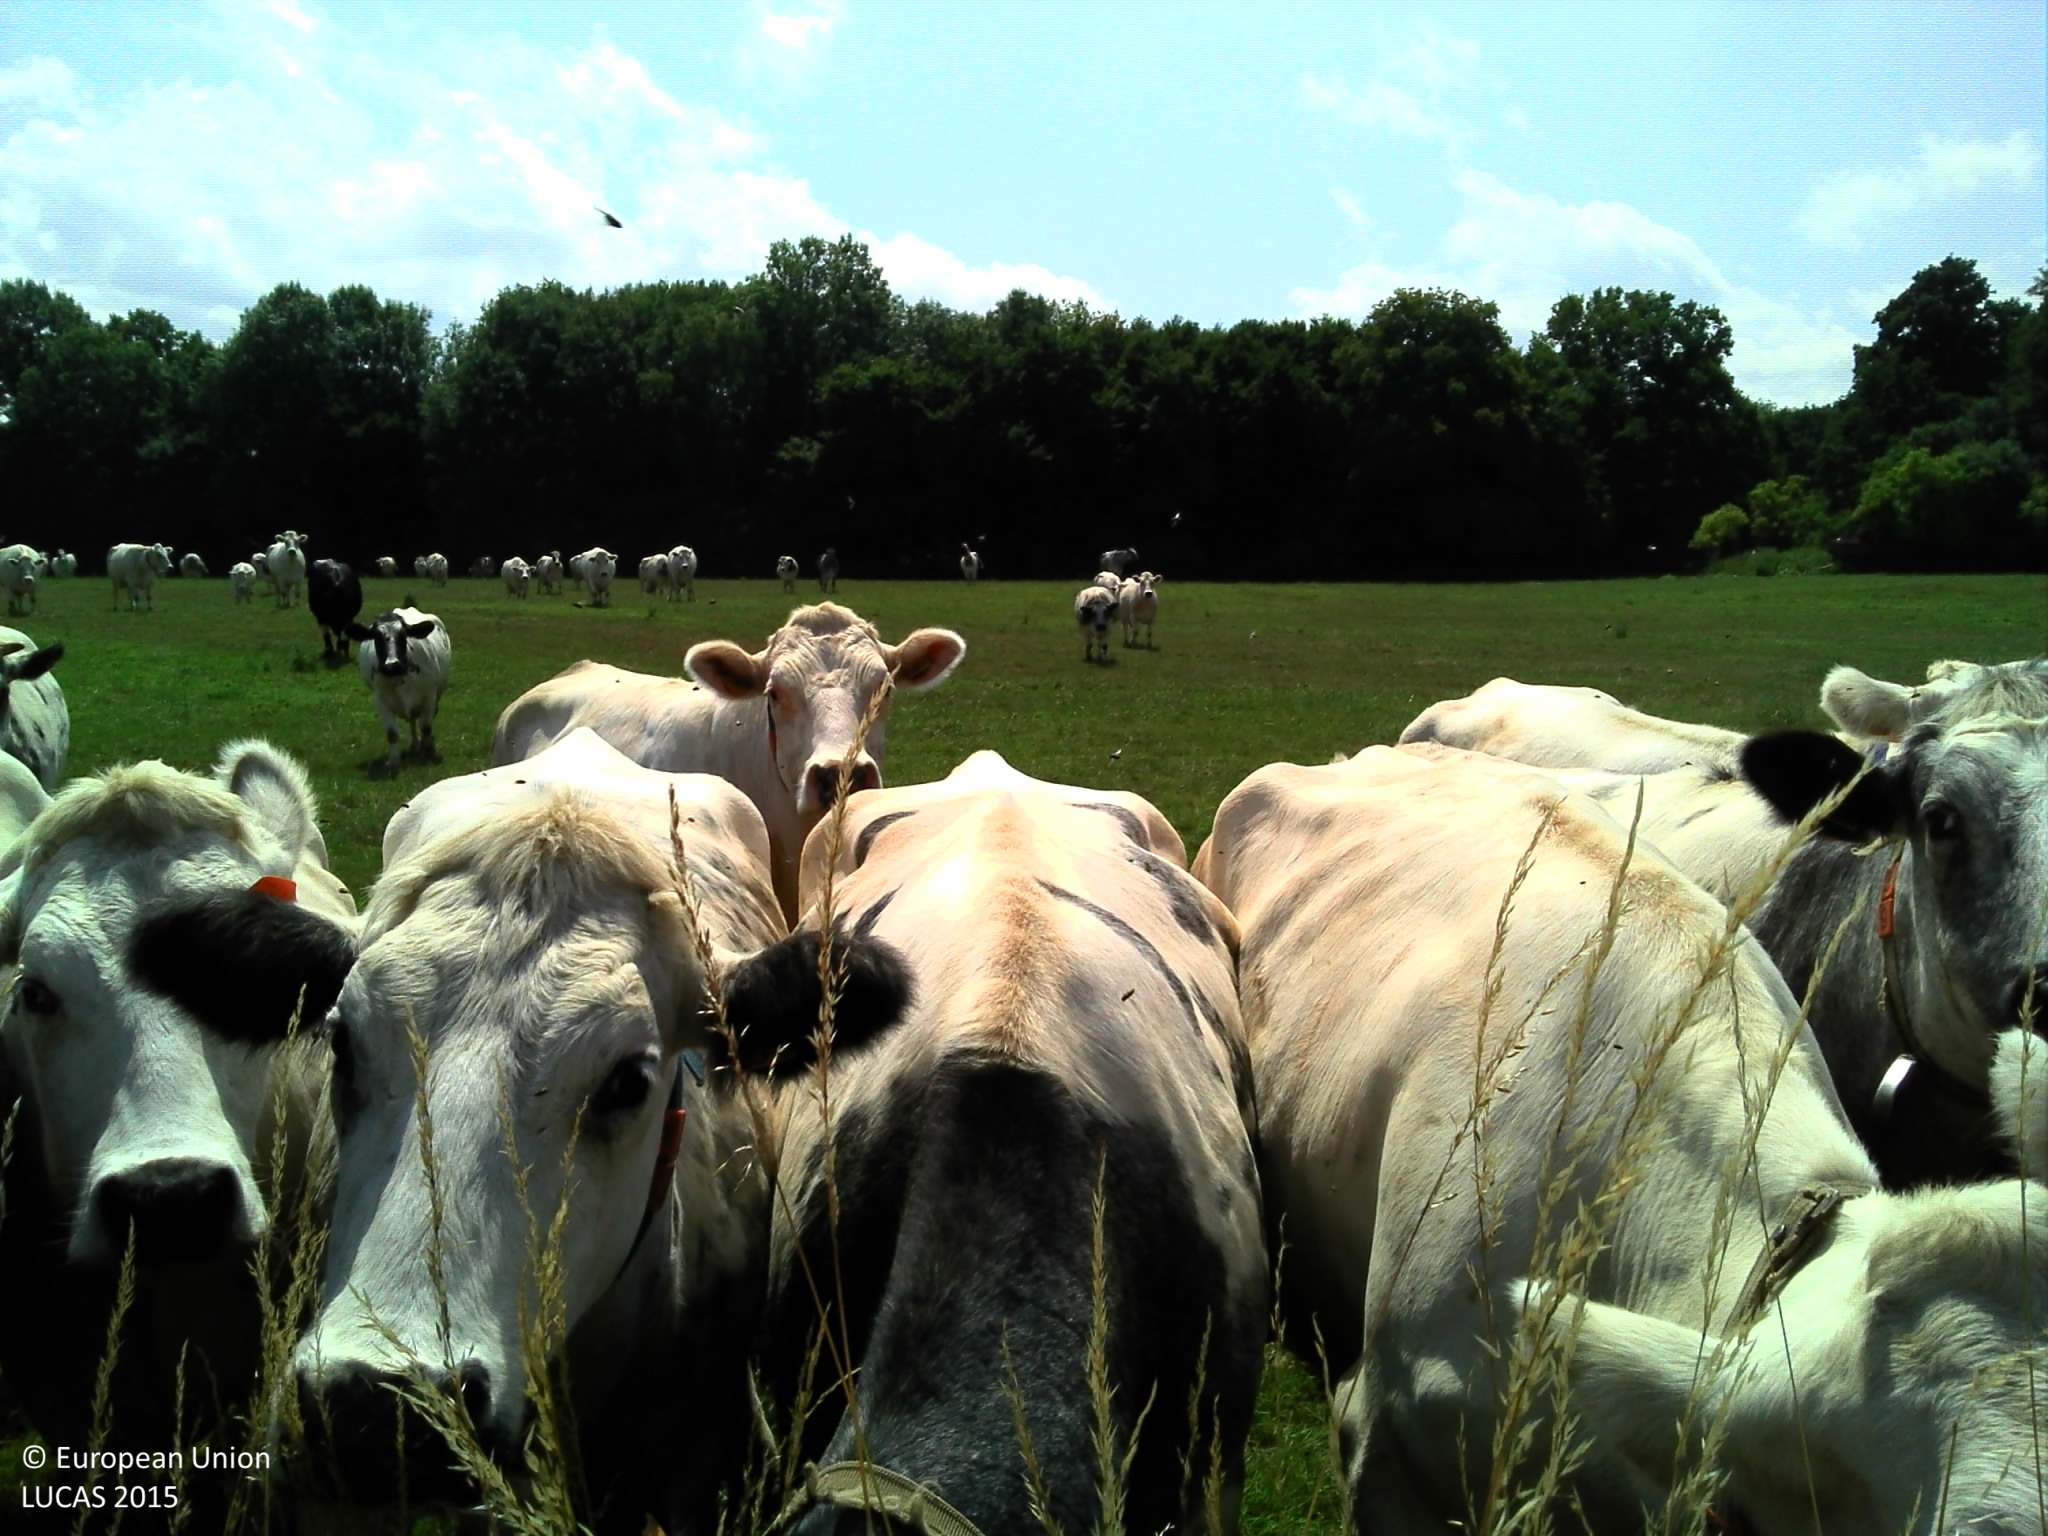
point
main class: Grassland
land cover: Grassland without tree/shrub cover
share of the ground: > 75 %
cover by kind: herbaceous plants 100 %
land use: Agriculture (excluding fallow land and kitchen gardens)
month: July
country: BE
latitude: 50.2889
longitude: 4.1982
